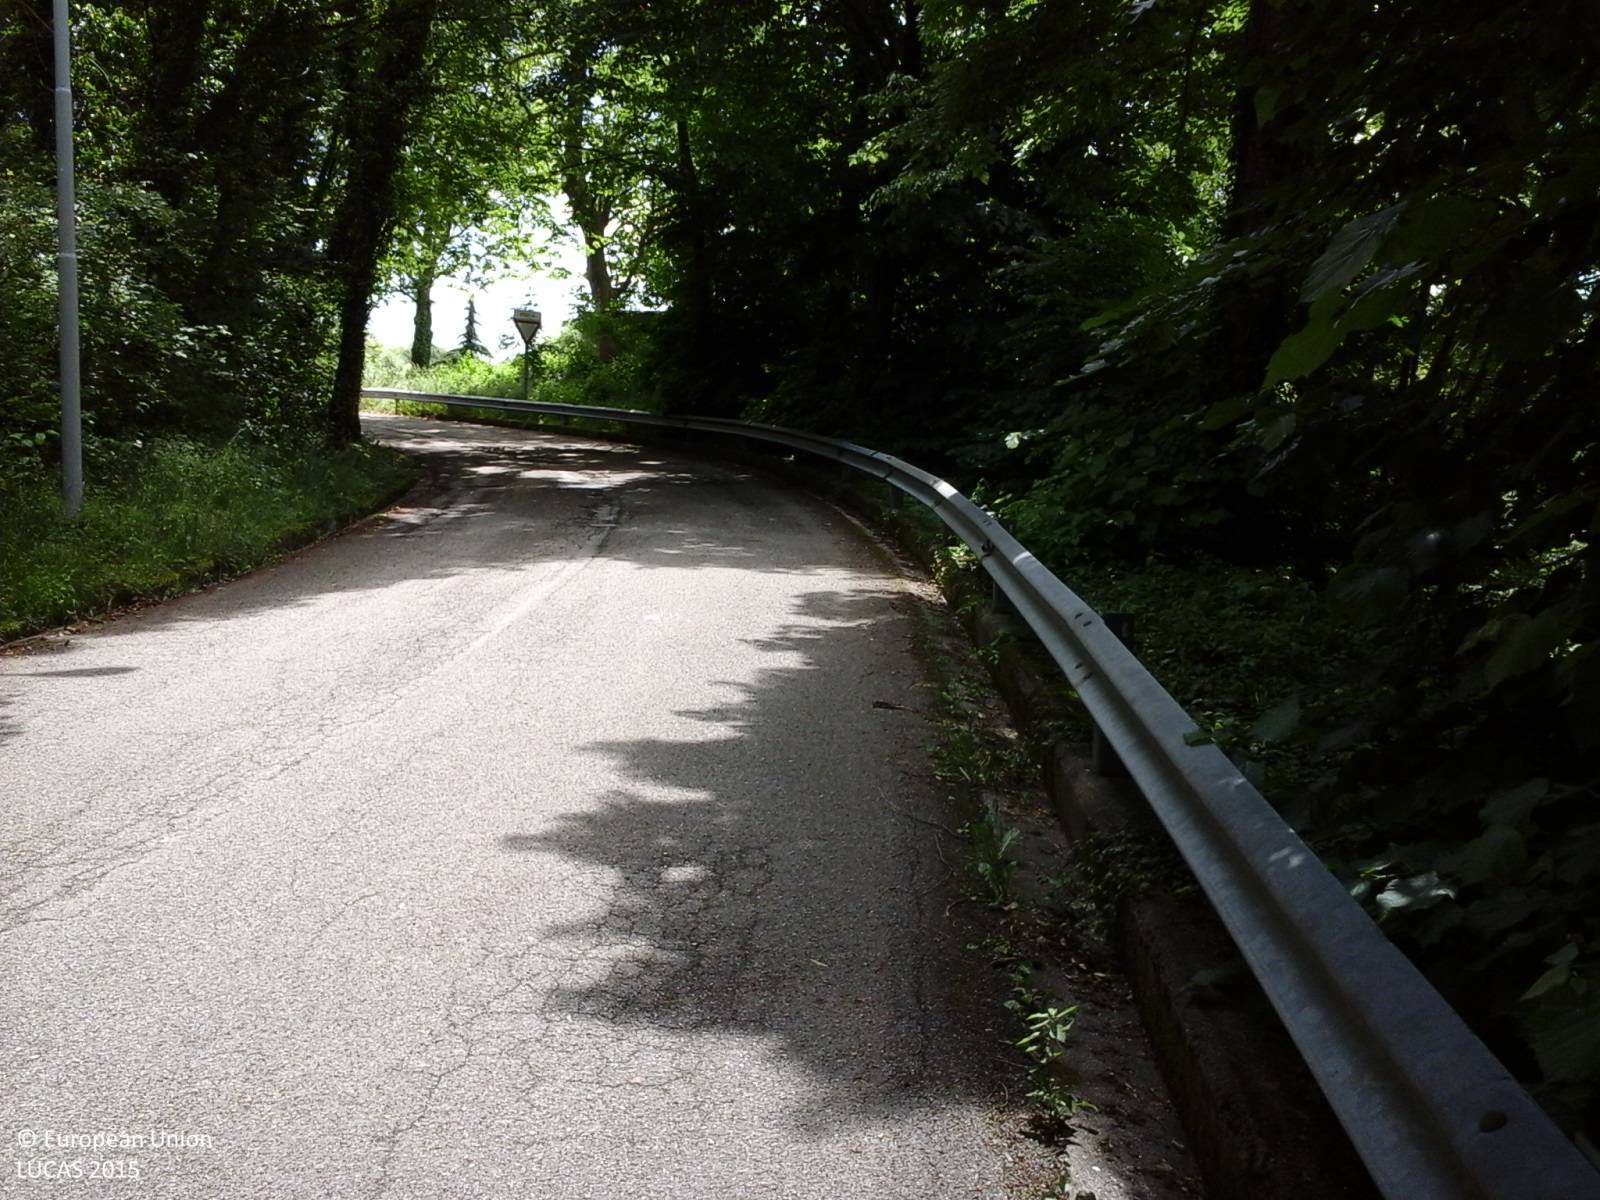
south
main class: Woodland
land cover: Broadleaved woodland
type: thermophilous deciduous forest
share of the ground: > 75 %
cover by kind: broadleaved forest trees 95 %, shrubs 5 %
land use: Forestry
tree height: > 5 m
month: May
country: IT
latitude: 46.2305
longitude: 13.2253
